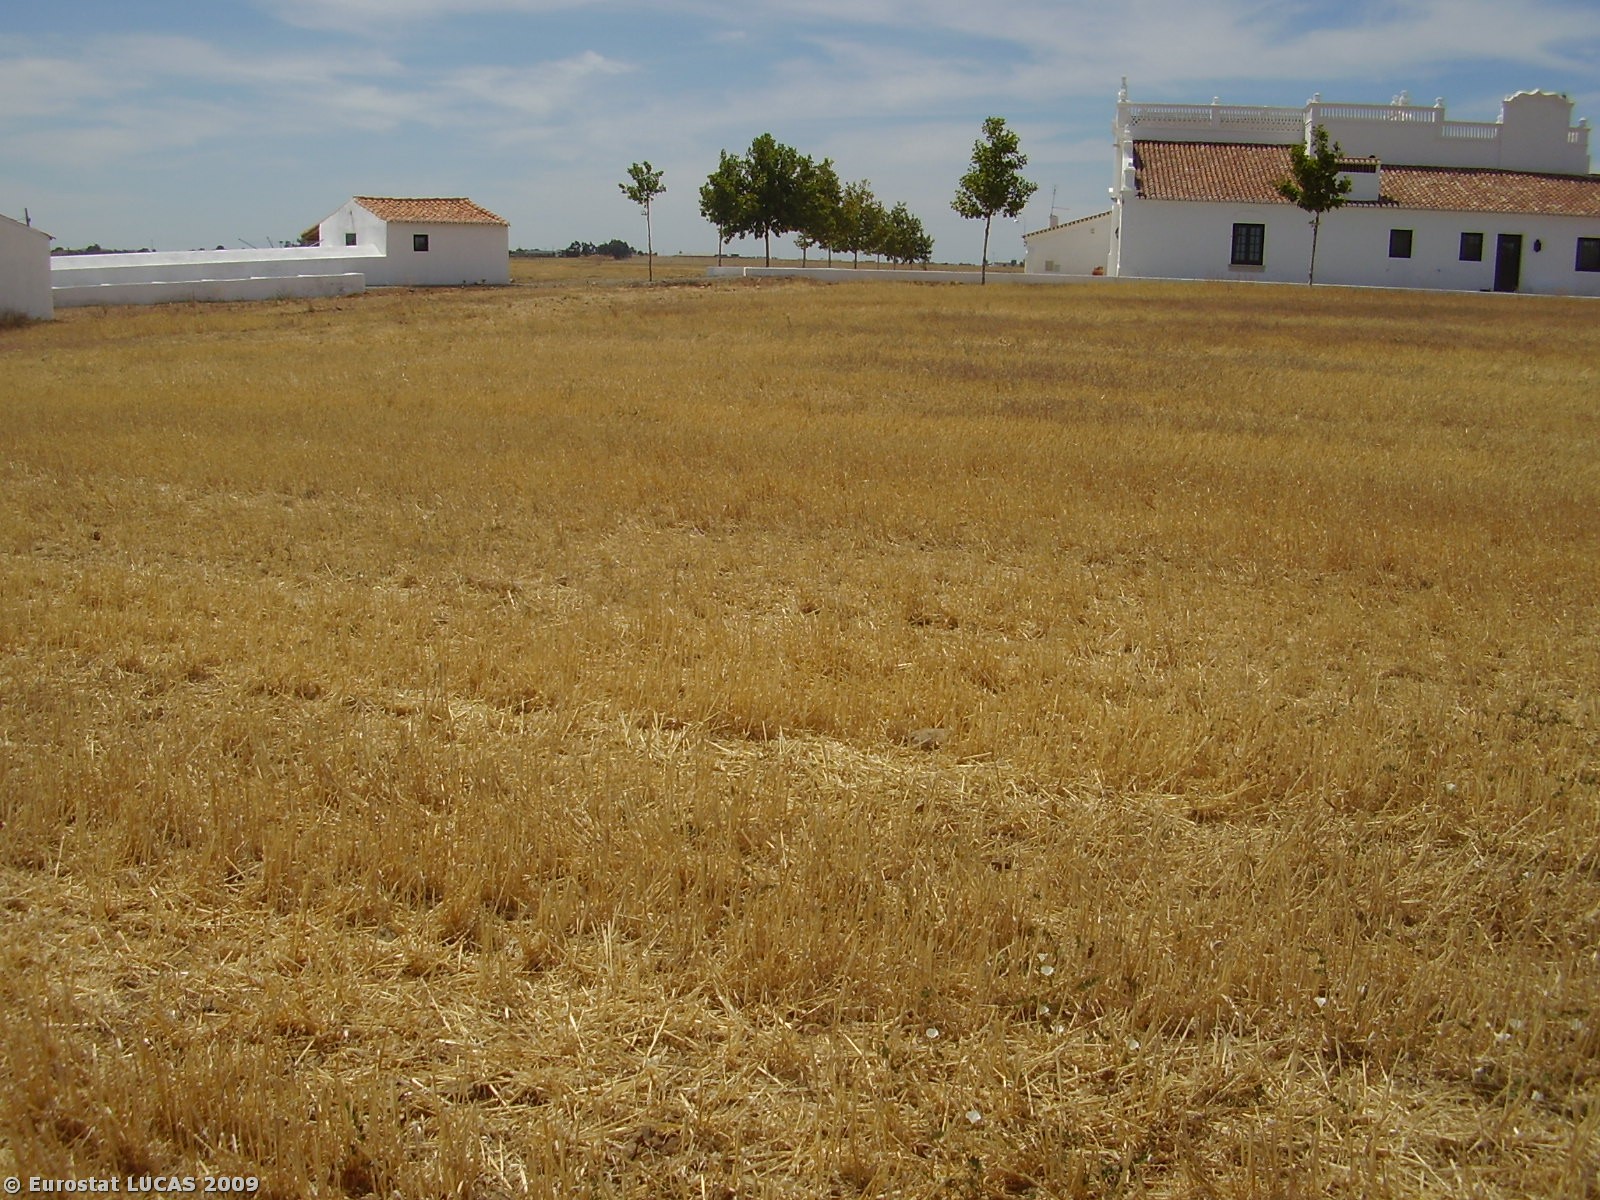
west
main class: Cropland
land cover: Common wheat
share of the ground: > 75 %
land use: Agriculture (excluding fallow land and kitchen gardens)
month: August
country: PT
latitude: 38.0622
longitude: -7.8426
